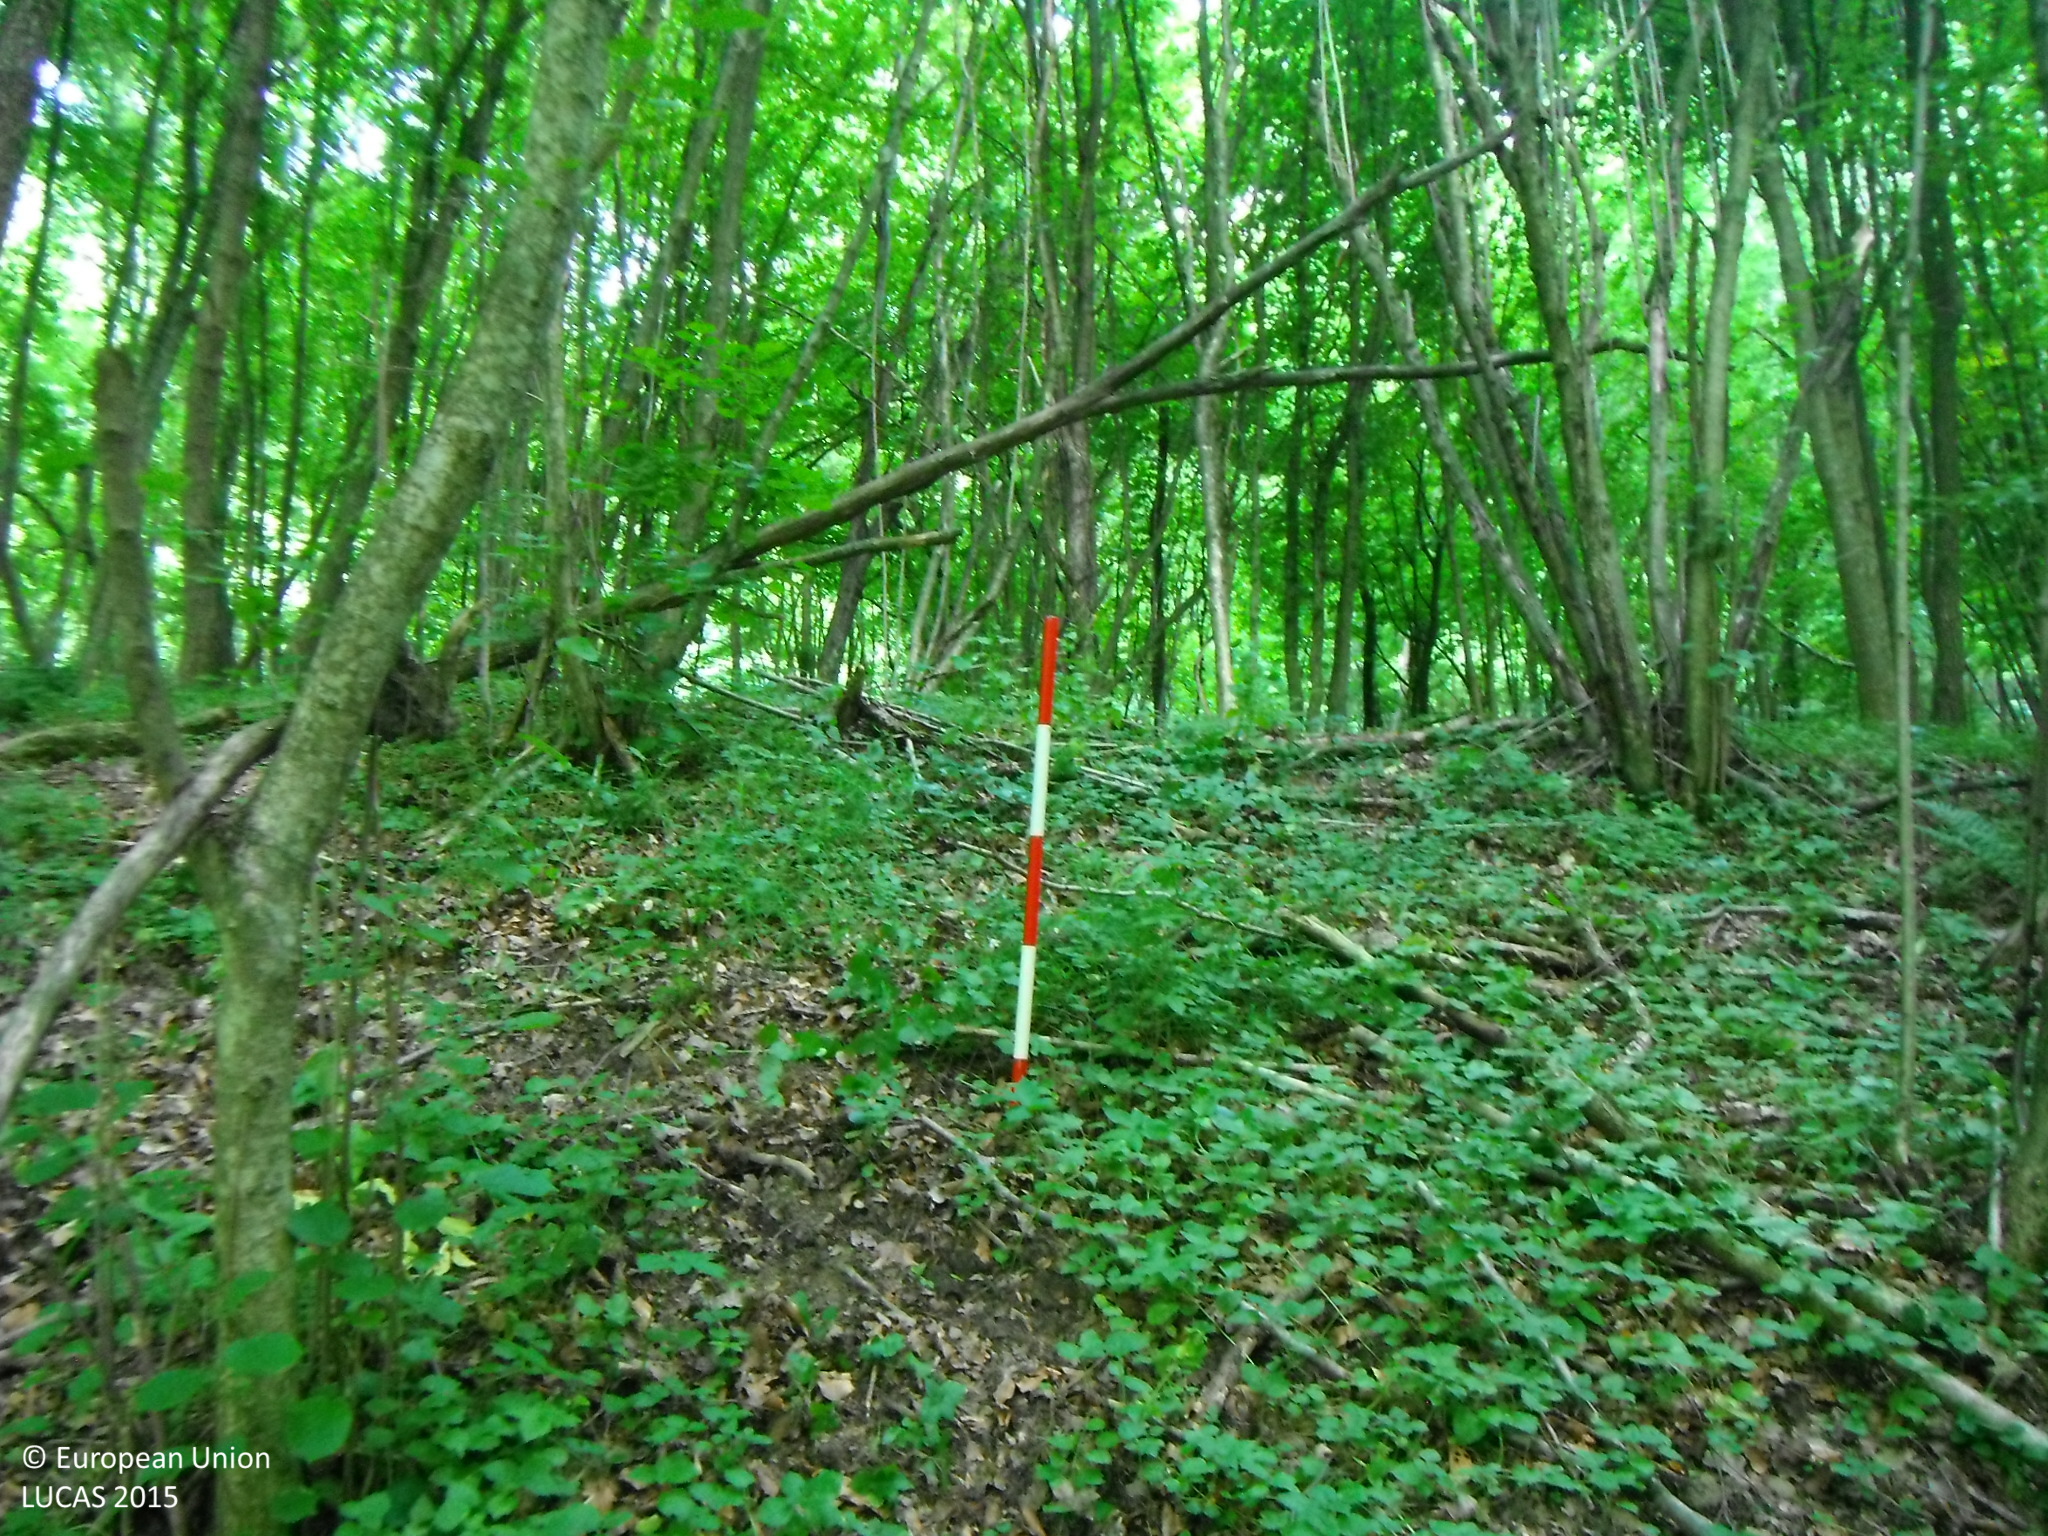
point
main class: Woodland
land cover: Broadleaved woodland
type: beech forest
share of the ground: > 75 %
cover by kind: broadleaved forest trees 100 %
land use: Forestry
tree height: > 5 m
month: July
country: SK
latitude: 49.0768
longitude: 21.8127
